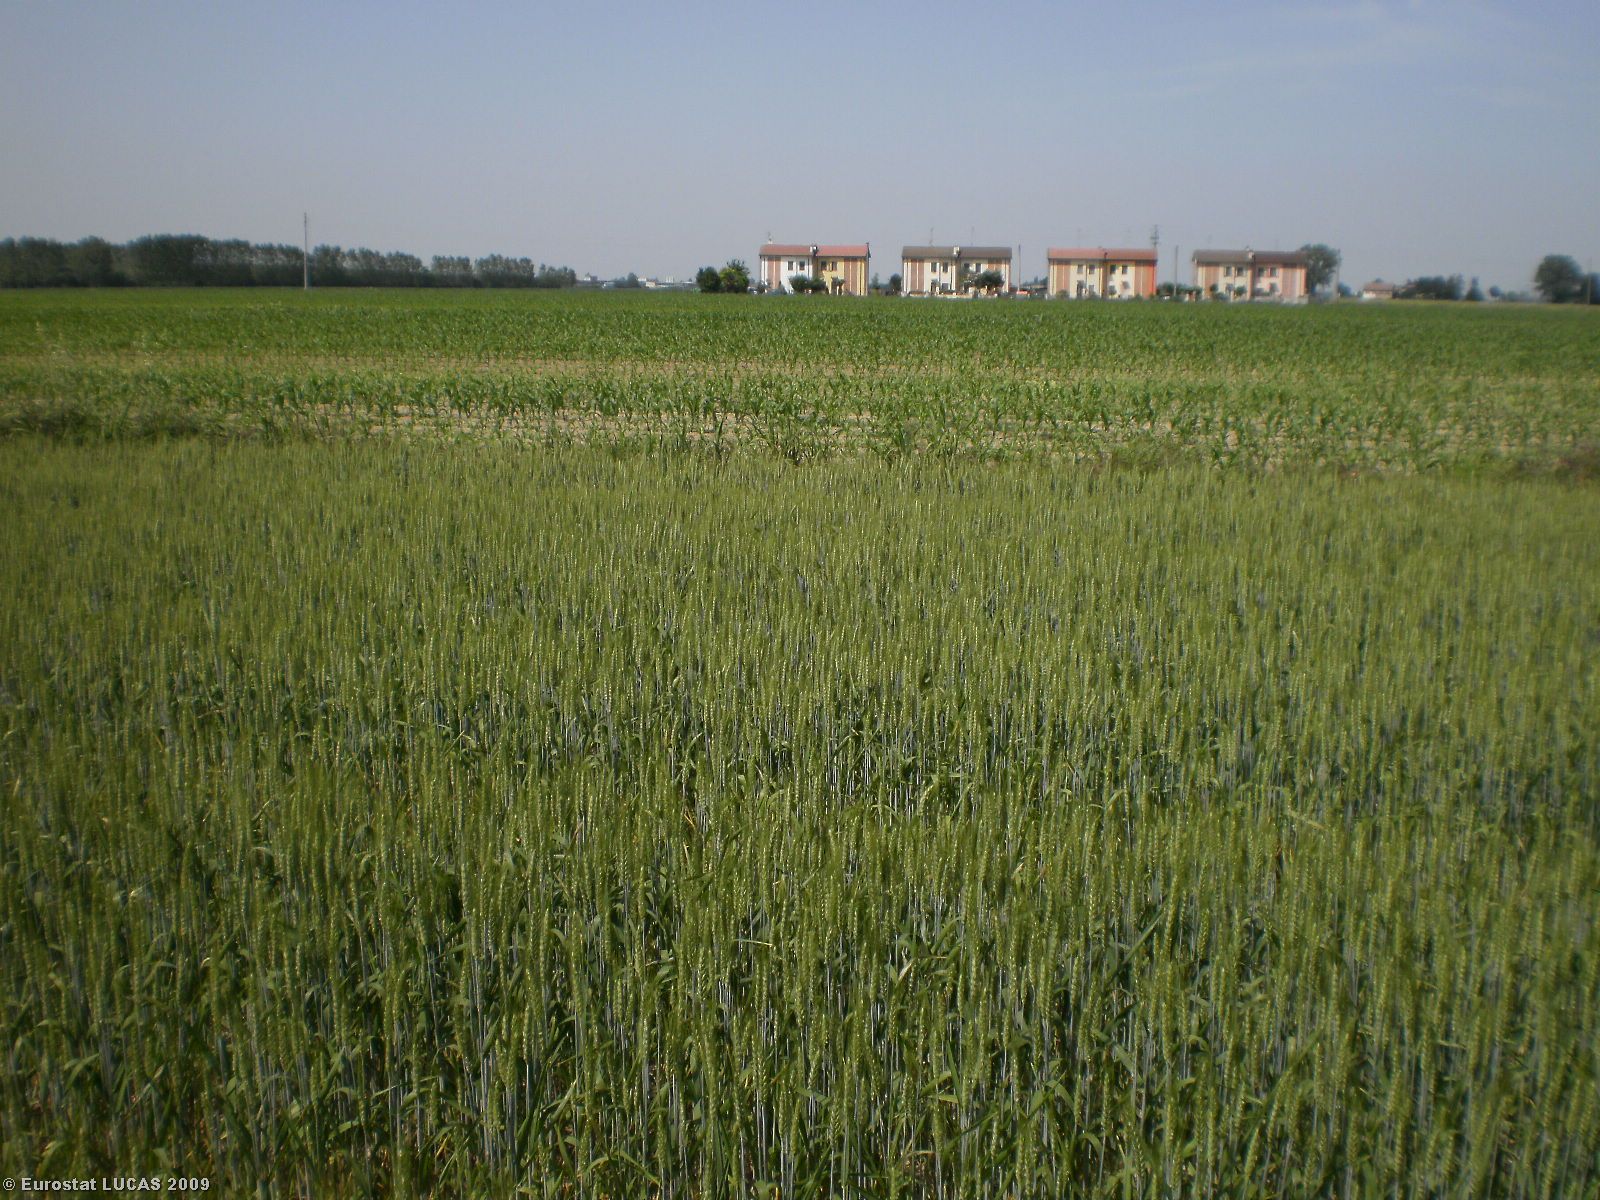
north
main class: Cropland
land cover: Common wheat
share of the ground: > 75 %
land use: Agriculture (excluding fallow land and kitchen gardens)
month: May
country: IT
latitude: 45.0690
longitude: 10.7733
